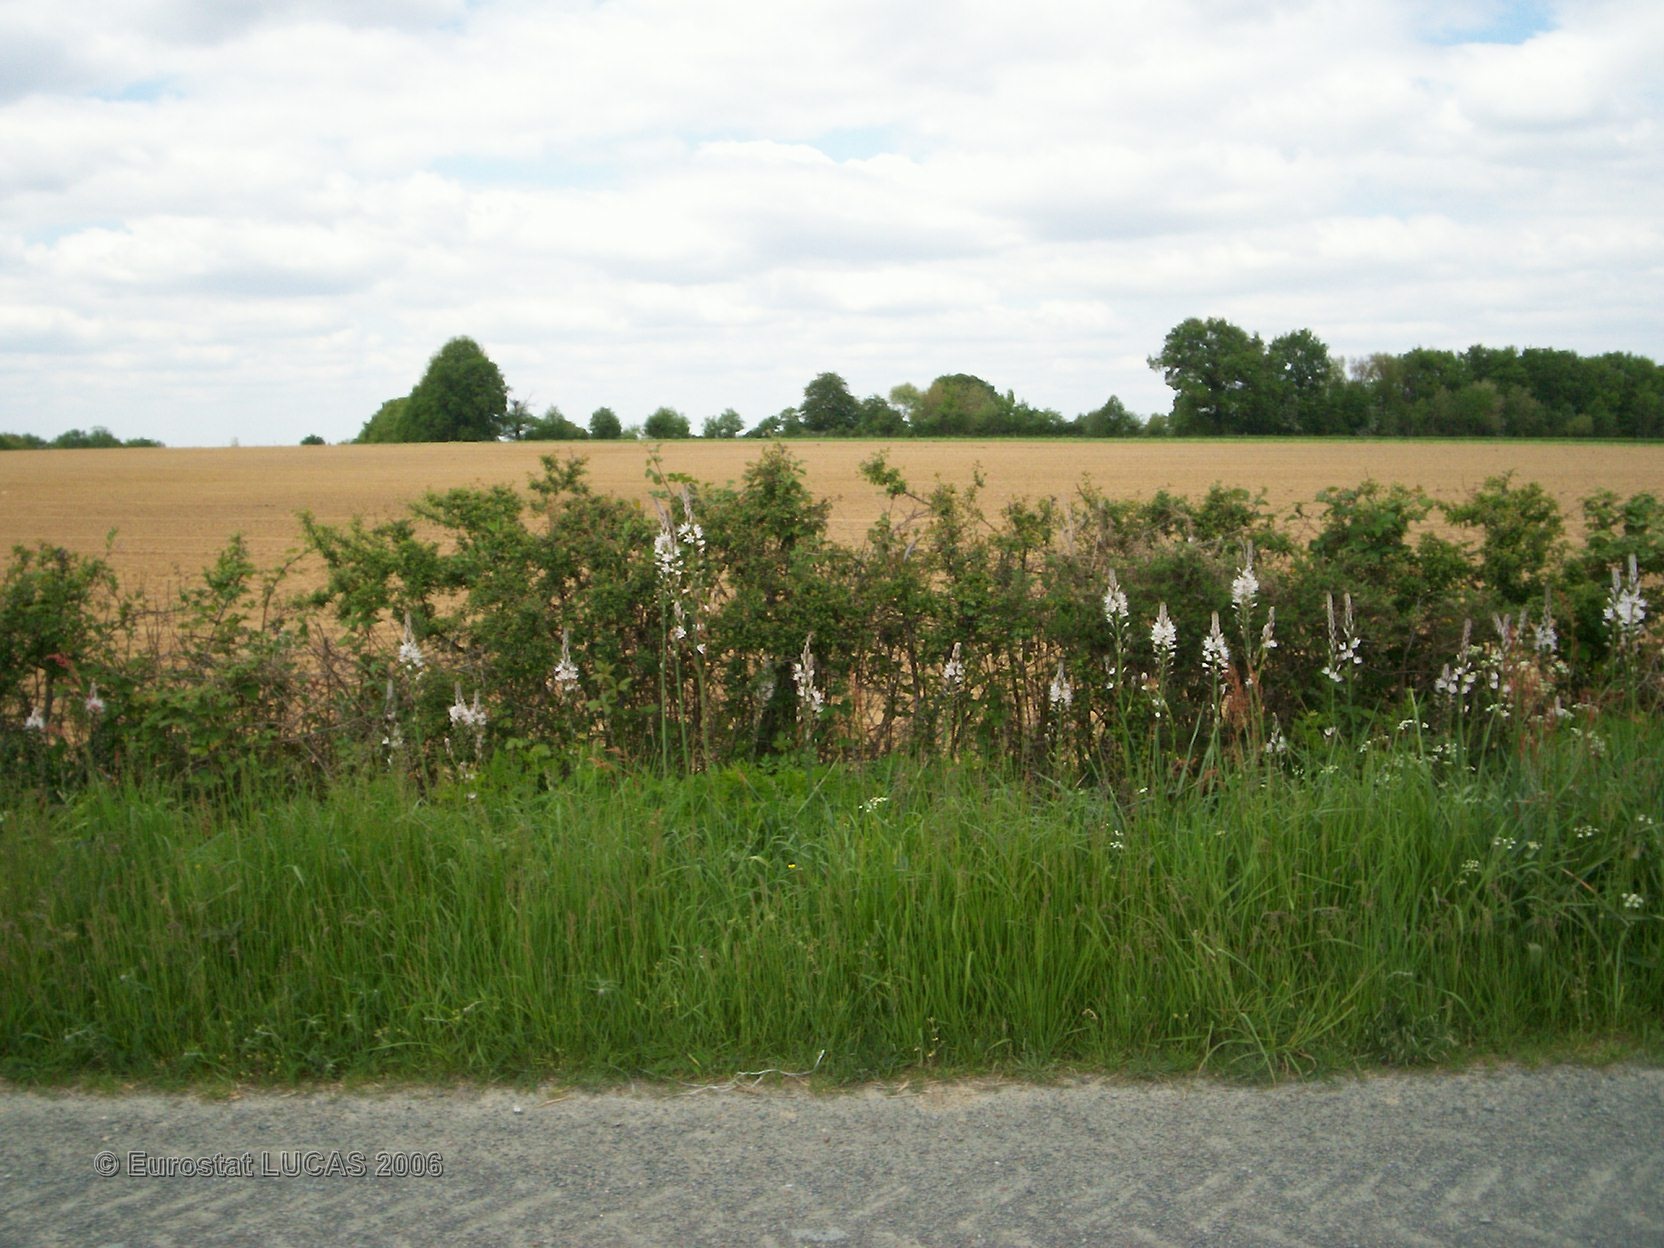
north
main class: Artificial land
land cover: Non built-up linear features
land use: Road transport
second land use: Agriculture (excluding fallow land and kitchen gardens)
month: May
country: FR
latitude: 46.6341
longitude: -1.0182
